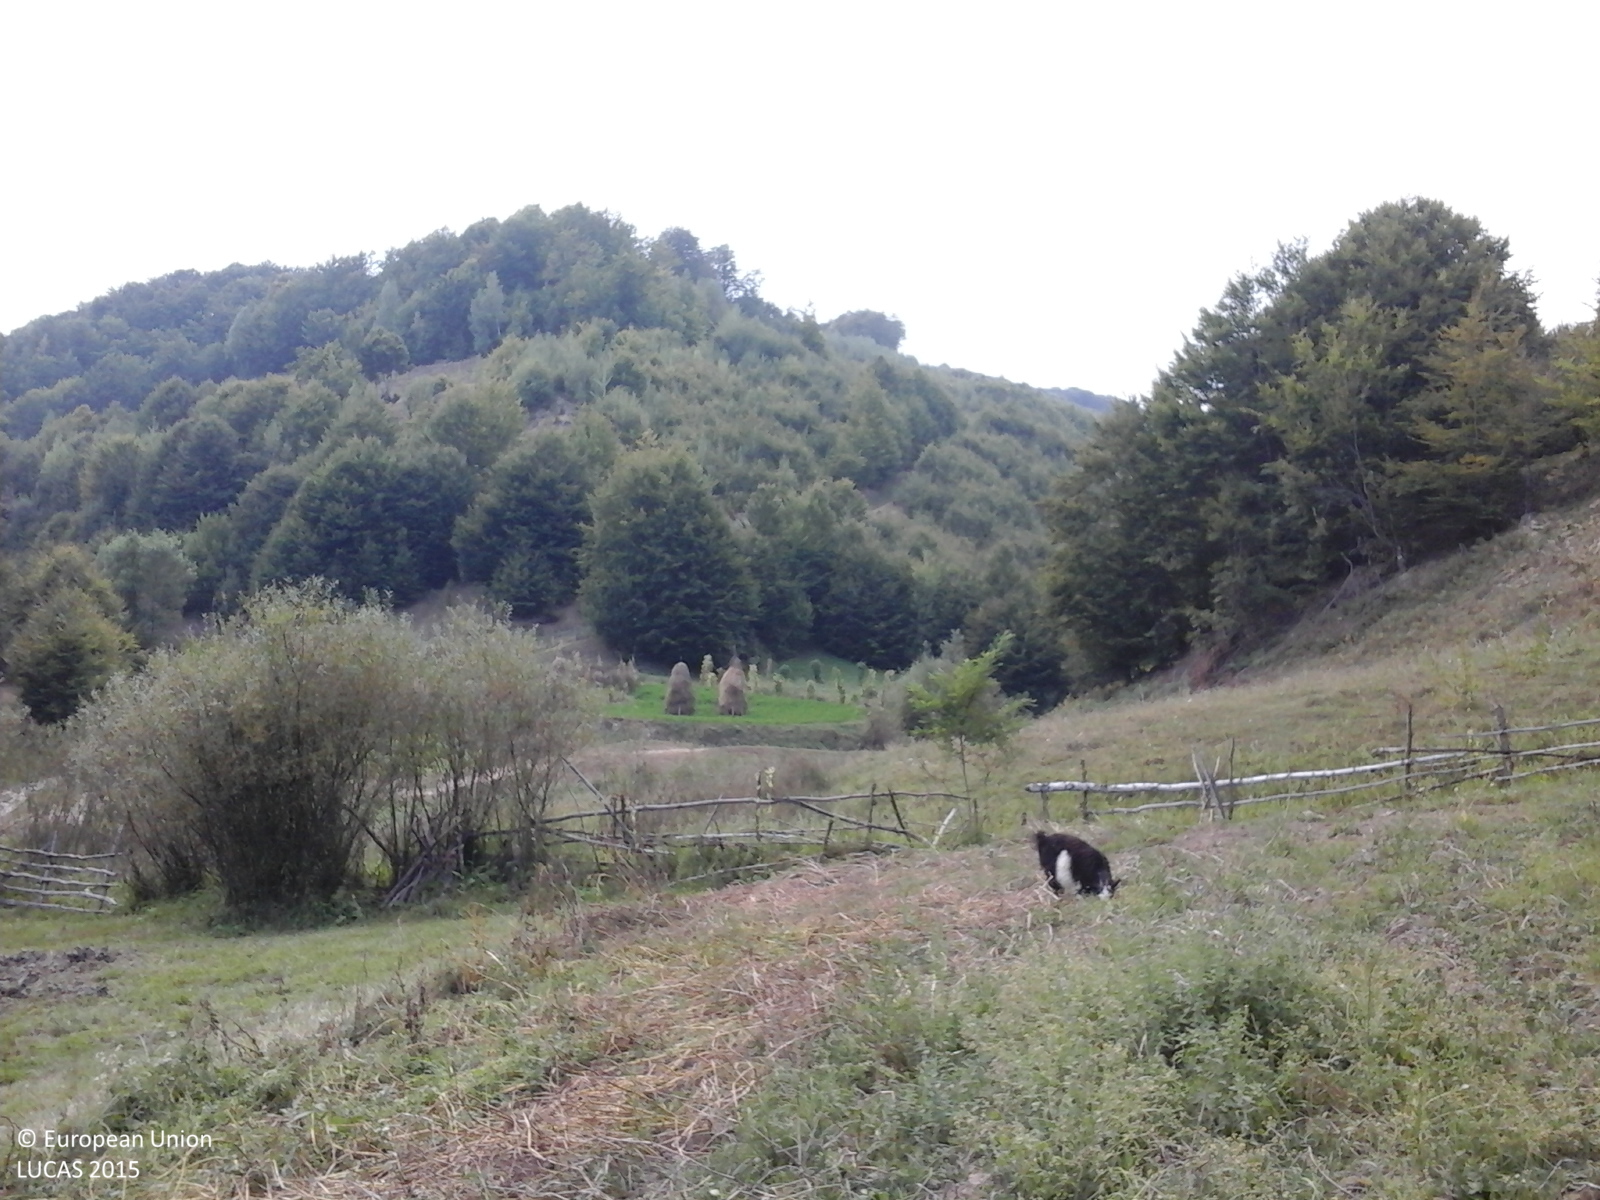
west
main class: Cropland
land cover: Potatoes
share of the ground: > 75 %
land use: Agriculture (excluding fallow land and kitchen gardens)
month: September
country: RO
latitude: 47.3835
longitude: 24.2475
